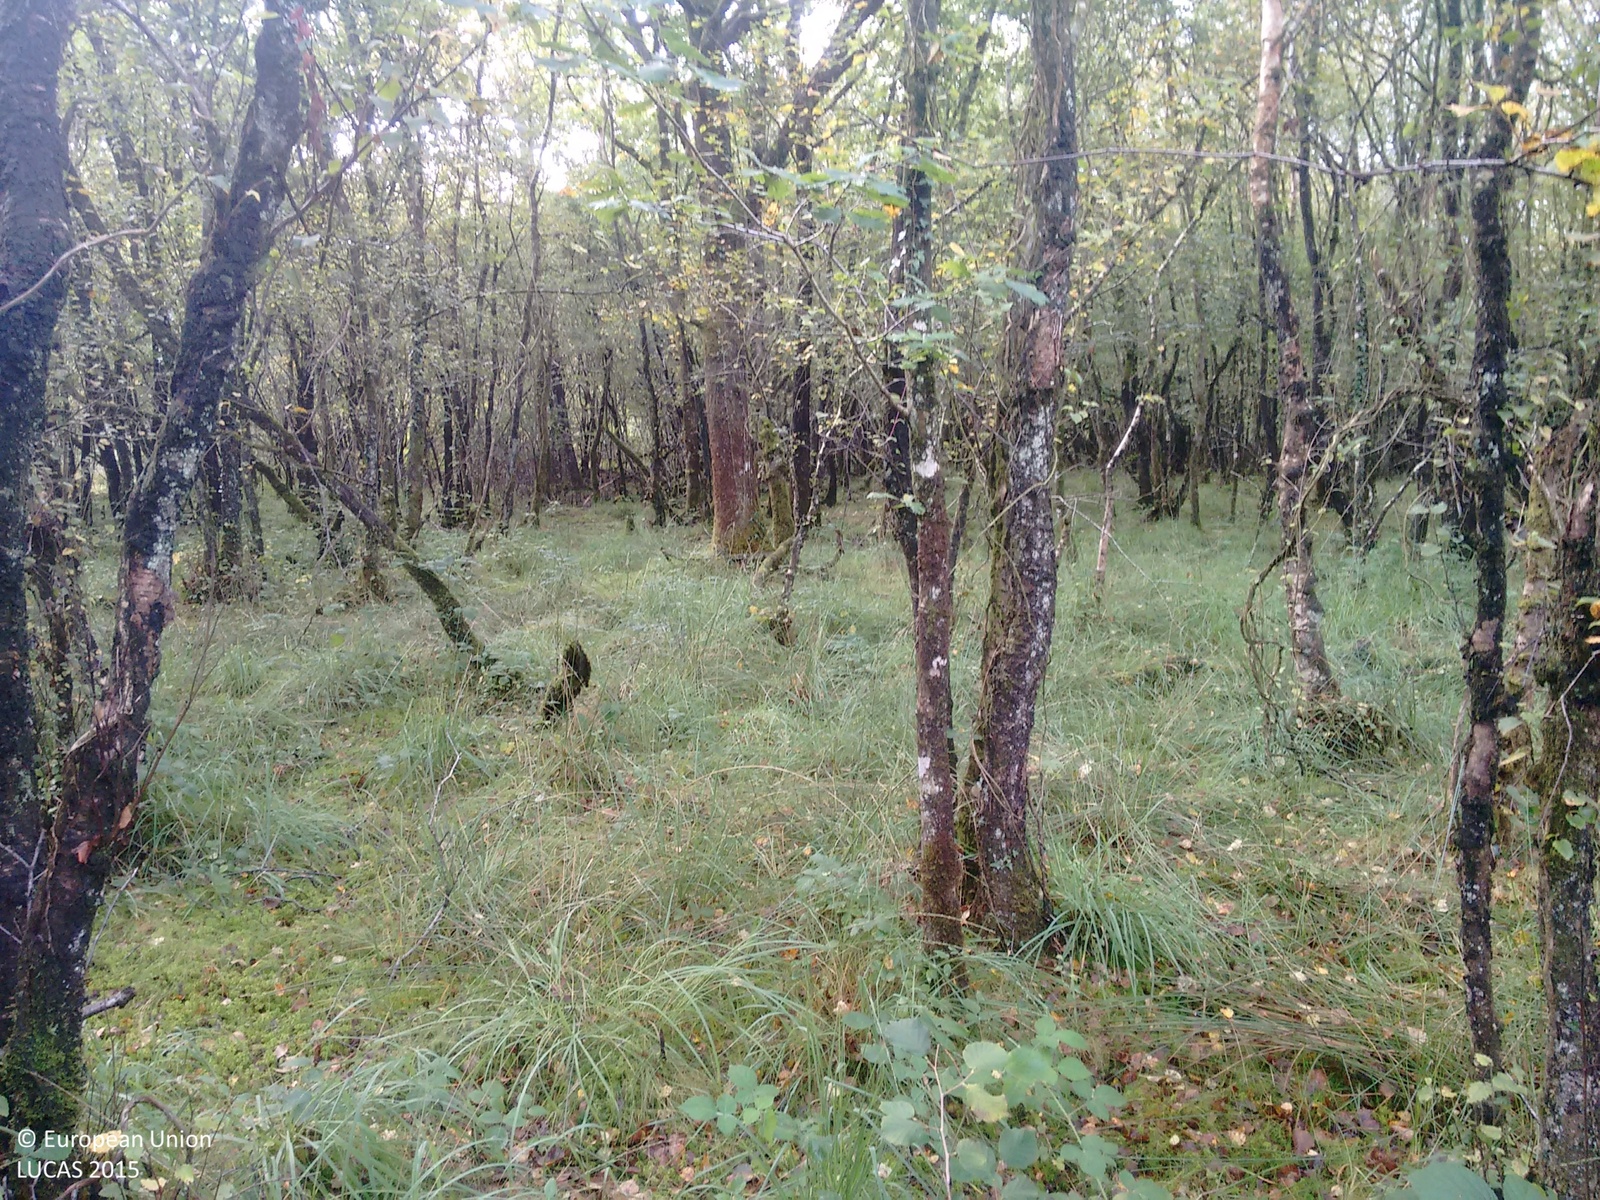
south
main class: Woodland
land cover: Broadleaved woodland
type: acidophilous oak and oak-birch forest
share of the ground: > 75 %
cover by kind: broadleaved forest trees 100 %
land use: Forestry
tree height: > 5 m
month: September
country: GB
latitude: 50.7612
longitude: -4.2622
